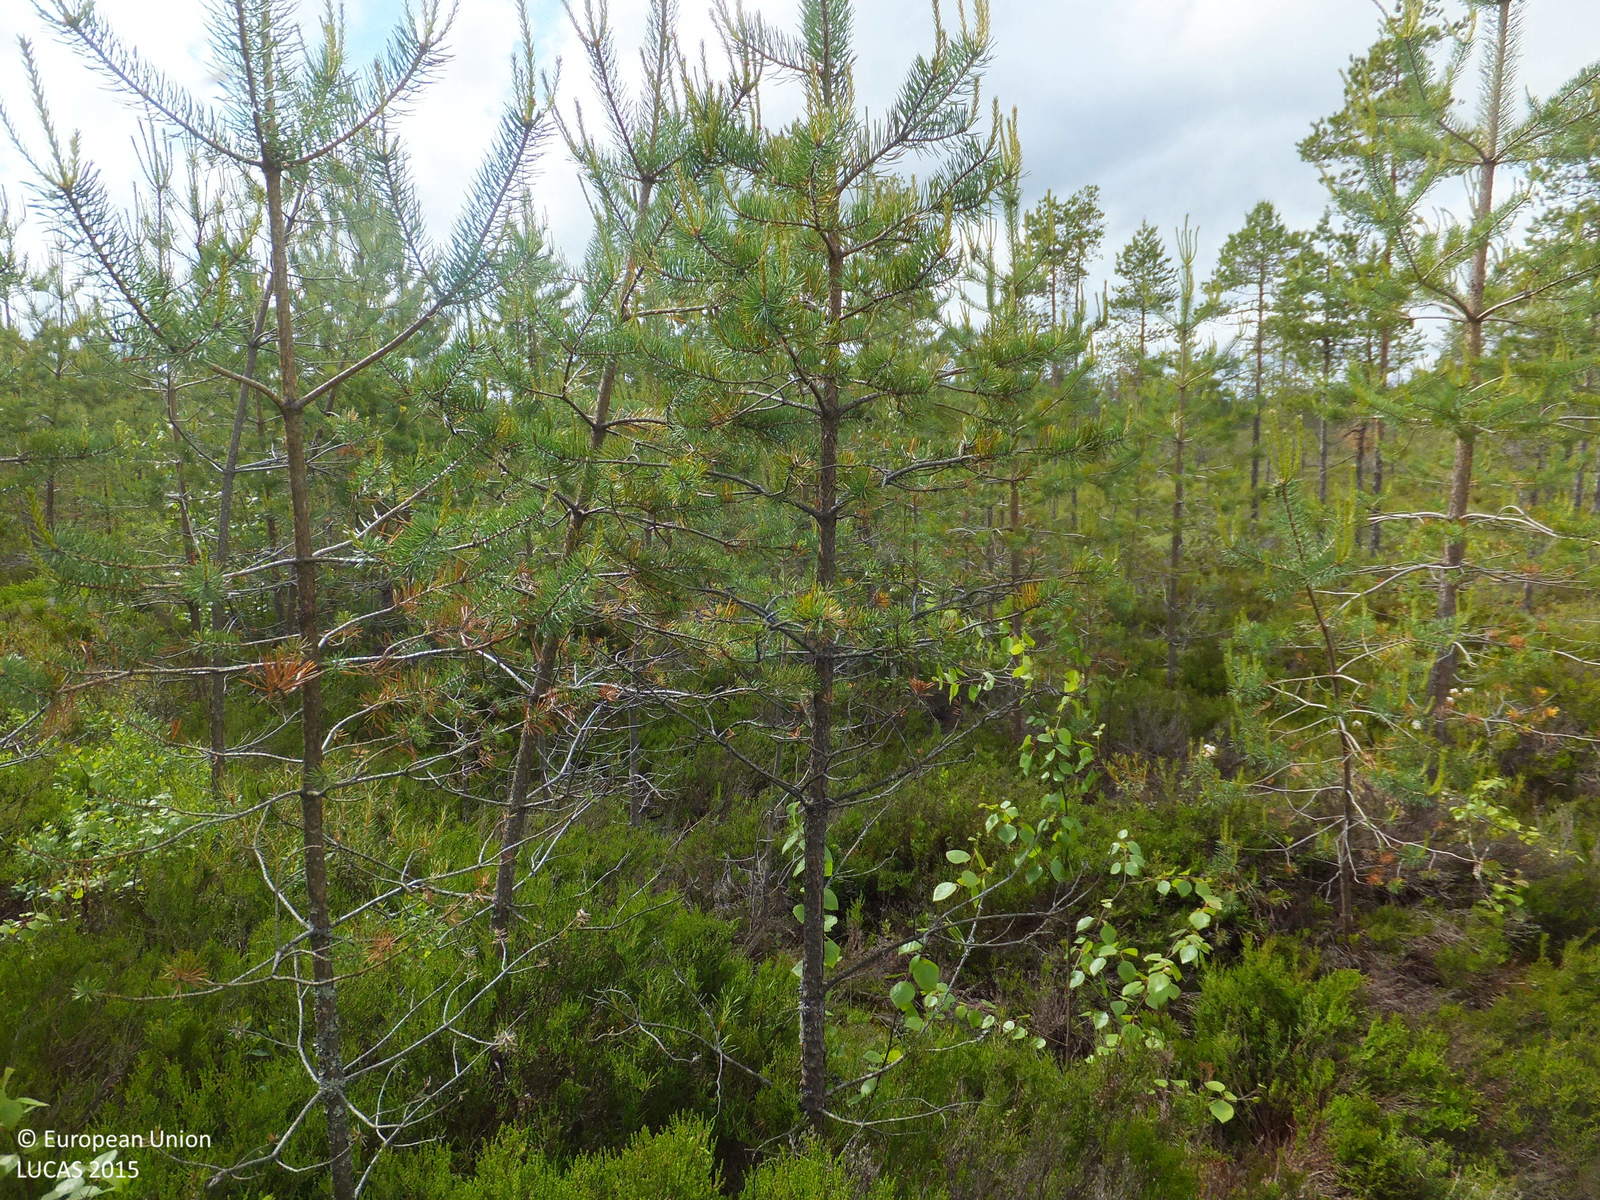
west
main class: Woodland
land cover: Pine dominated coniferous woodland
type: mire and swamp forests
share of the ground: > 75 %
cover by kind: coniferous forest trees 80 %, shrubs 10 %, broadleaved forest trees 5 %, lichens and mosses 5 %
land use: Forestry
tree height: < 5 m
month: June
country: FI
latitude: 63.2836
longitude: 23.9277
